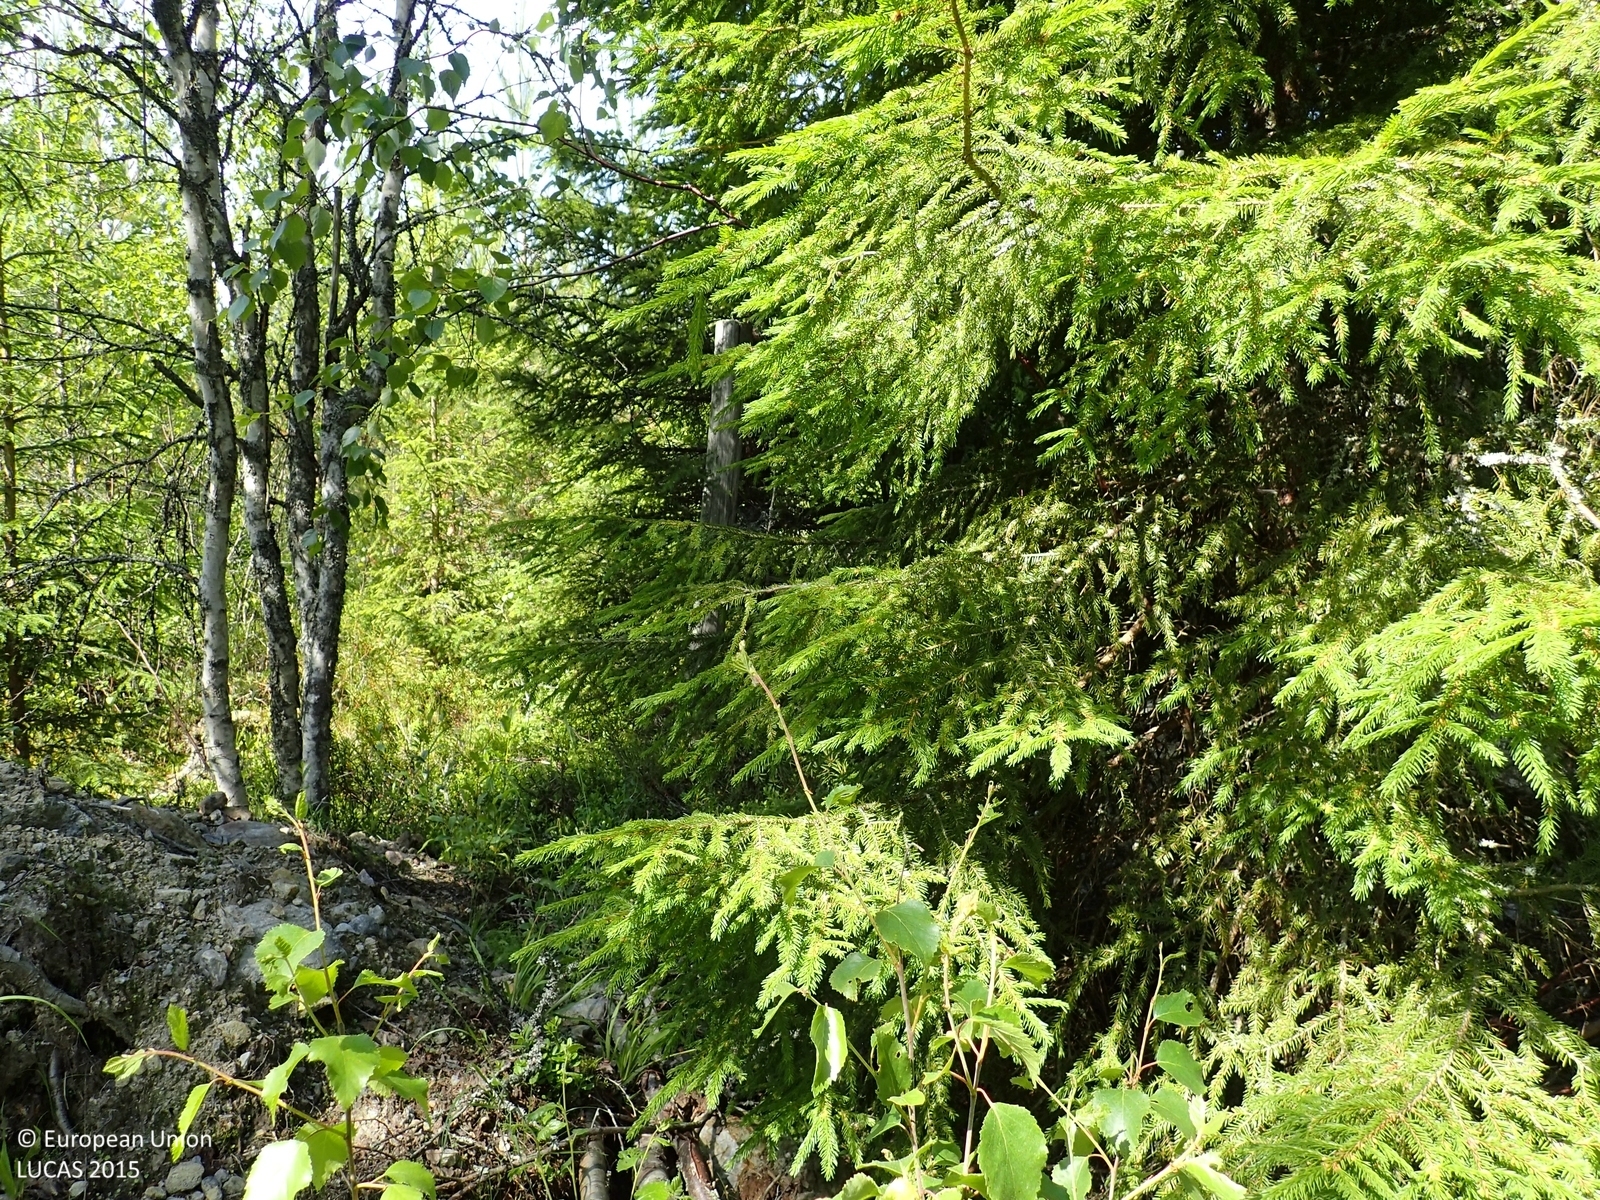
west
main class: Woodland
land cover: Spruce dominated mixed woodland
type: boreal forest
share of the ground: > 75 %
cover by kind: coniferous forest trees 45 %, broadleaved forest trees 40 %, shrubs 10 %, herbaceous plants 5 %
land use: Forestry
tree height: > 5 m
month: July
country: FI
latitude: 62.7726
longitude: 21.5023
